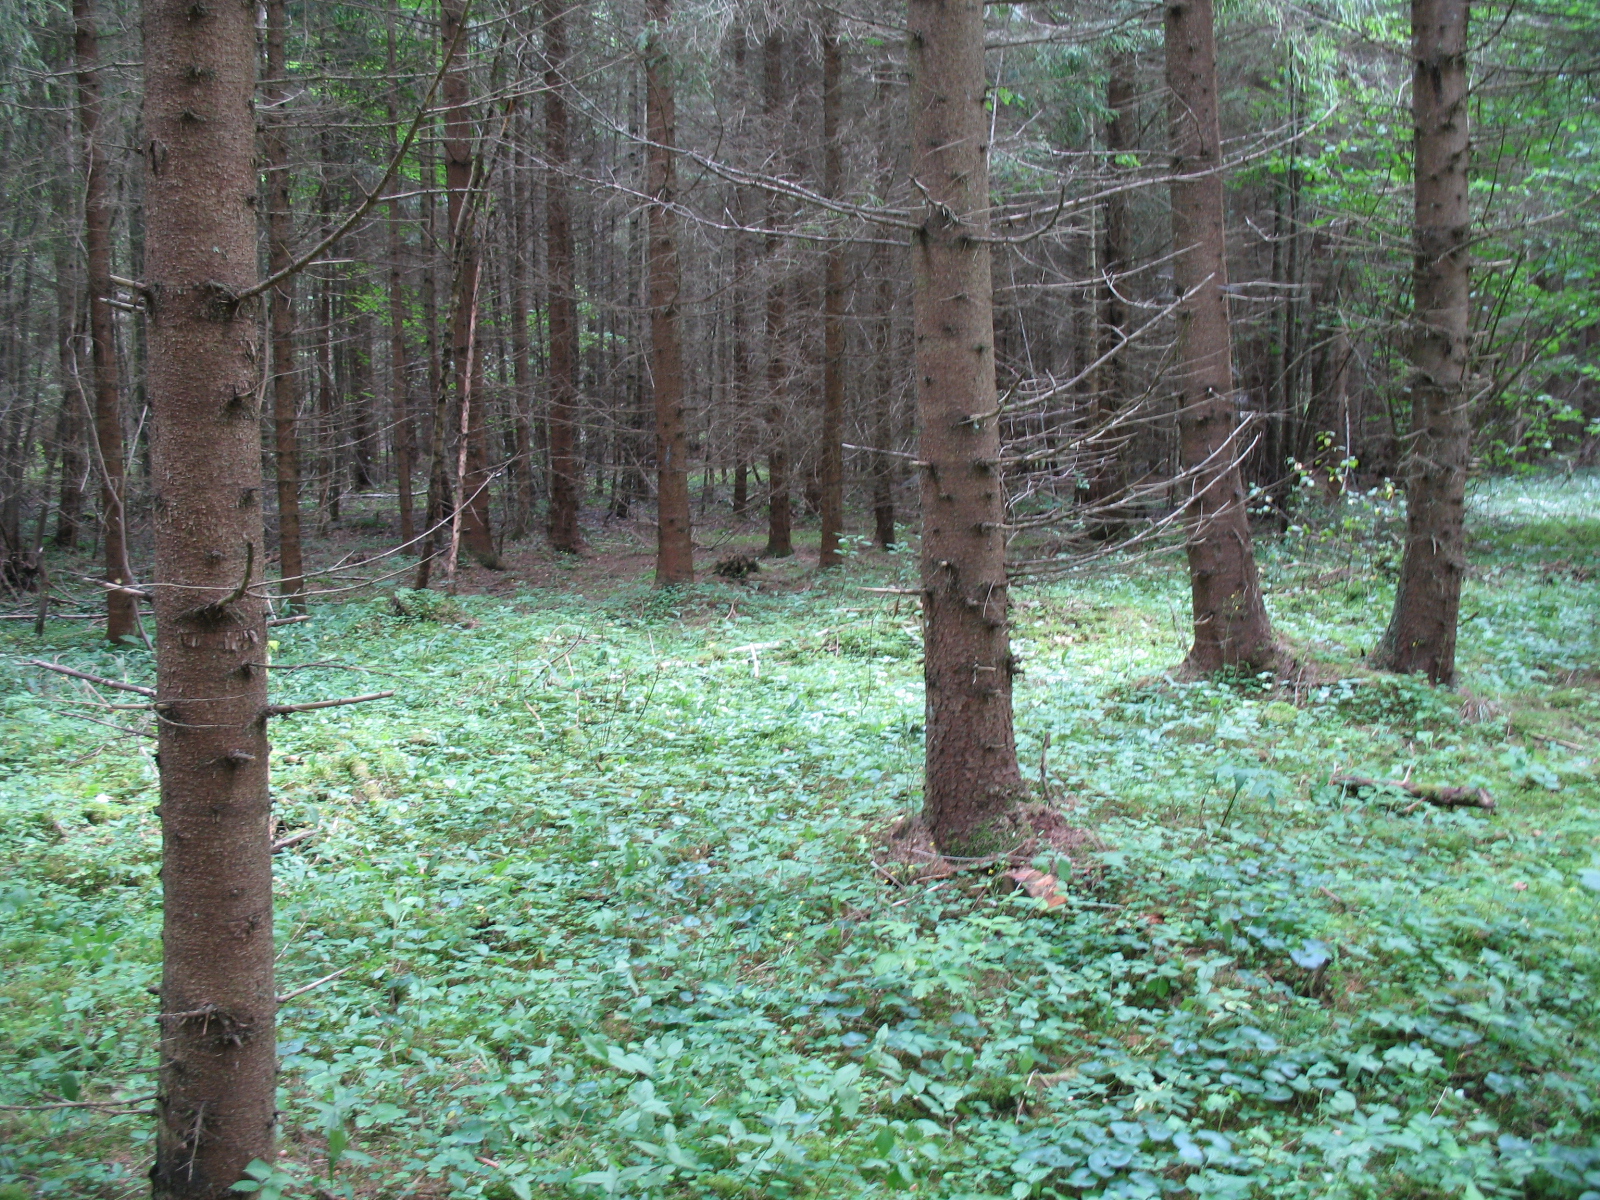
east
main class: Woodland
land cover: Spruce dominated coniferous woodland
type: hemiboreal forest and nemoral coniferous forest and mixed broadleaved-coniferous forest
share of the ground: > 75 %
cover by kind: coniferous forest trees 70 %, herbaceous plants 15 %, lichens and mosses 10 %, broadleaved forest trees 5 %
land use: Forestry
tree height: > 5 m
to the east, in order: Spruce dominated coniferous woodland; Spruce dominated mixed woodland; Broadleaved woodland; Spontaneously vegetated surfaces
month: July
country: LV
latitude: 56.3875
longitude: 25.0930
